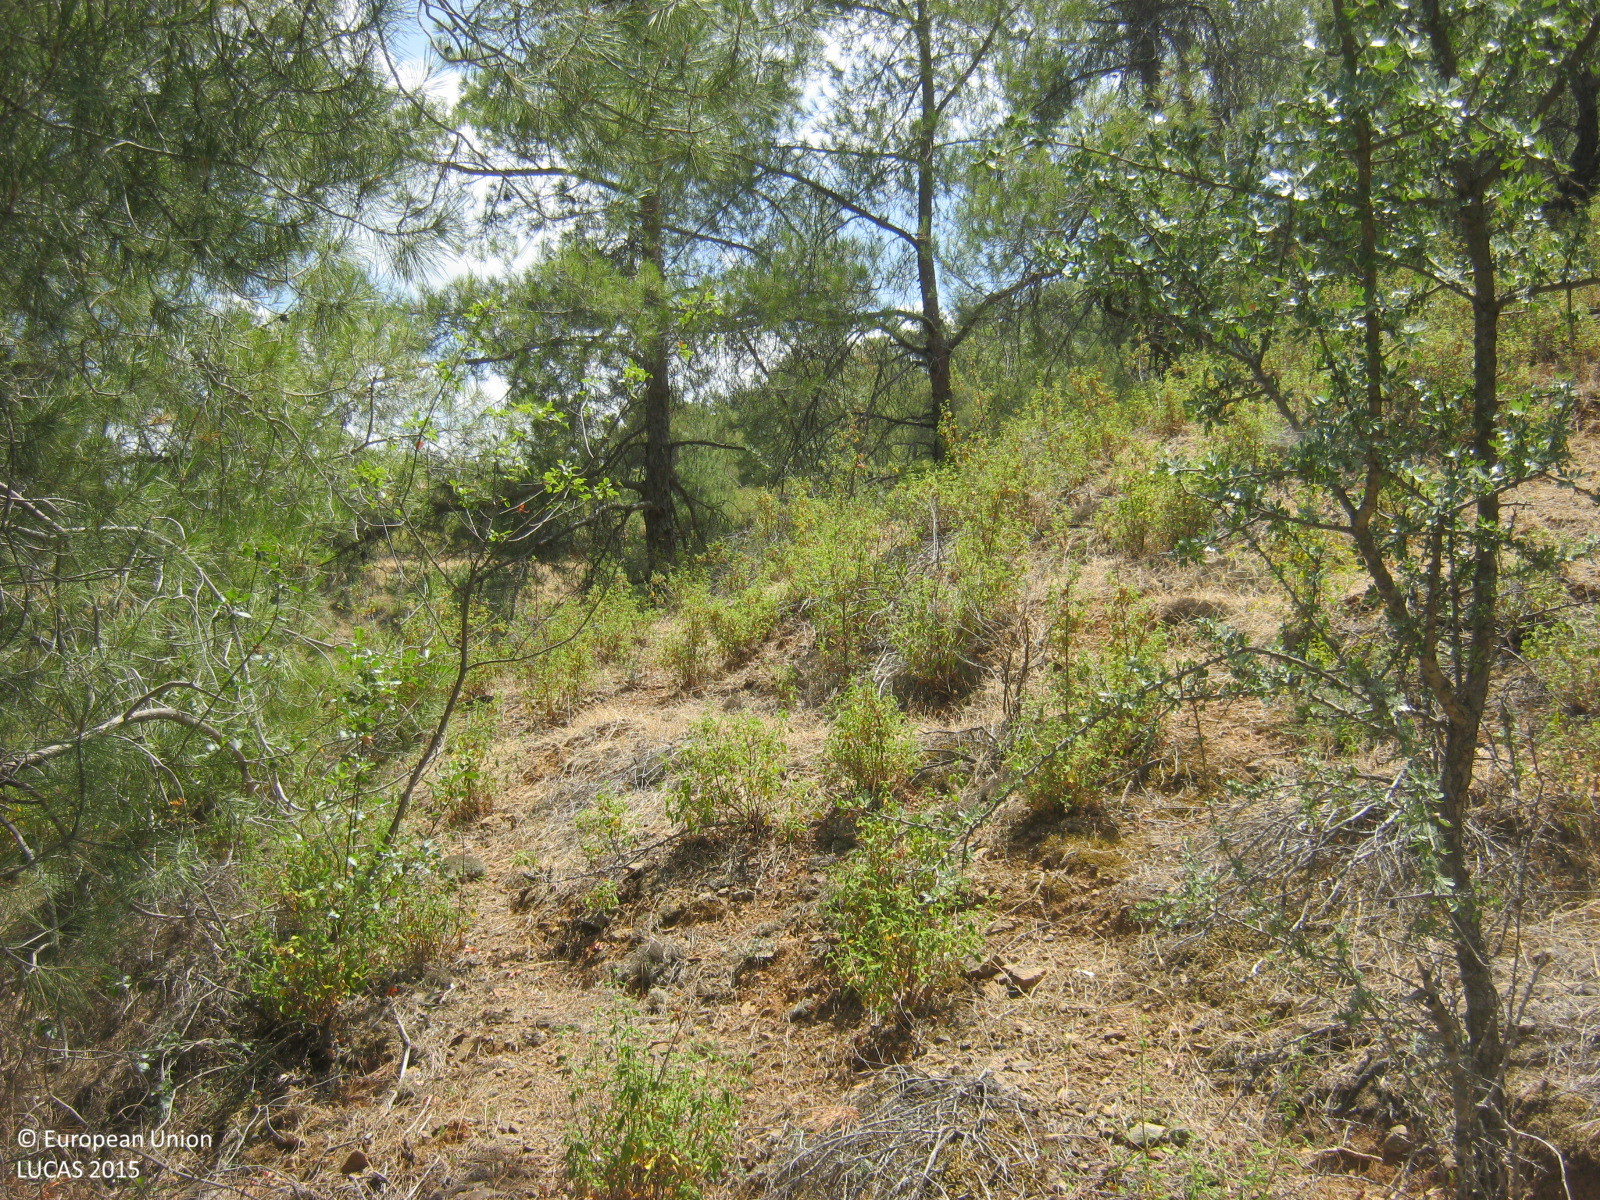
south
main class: Woodland
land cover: Pine dominated coniferous woodland
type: coniferous forest of the mediterranean region
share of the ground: 50 - 75 %
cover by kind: coniferous forest trees 60 %, shrubs 20 %, broadleaved forest trees 10 %, unconsolidated bare surface 10 %
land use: Forestry
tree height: > 5 m
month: June
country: CY
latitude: 34.9925
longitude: 33.1767
